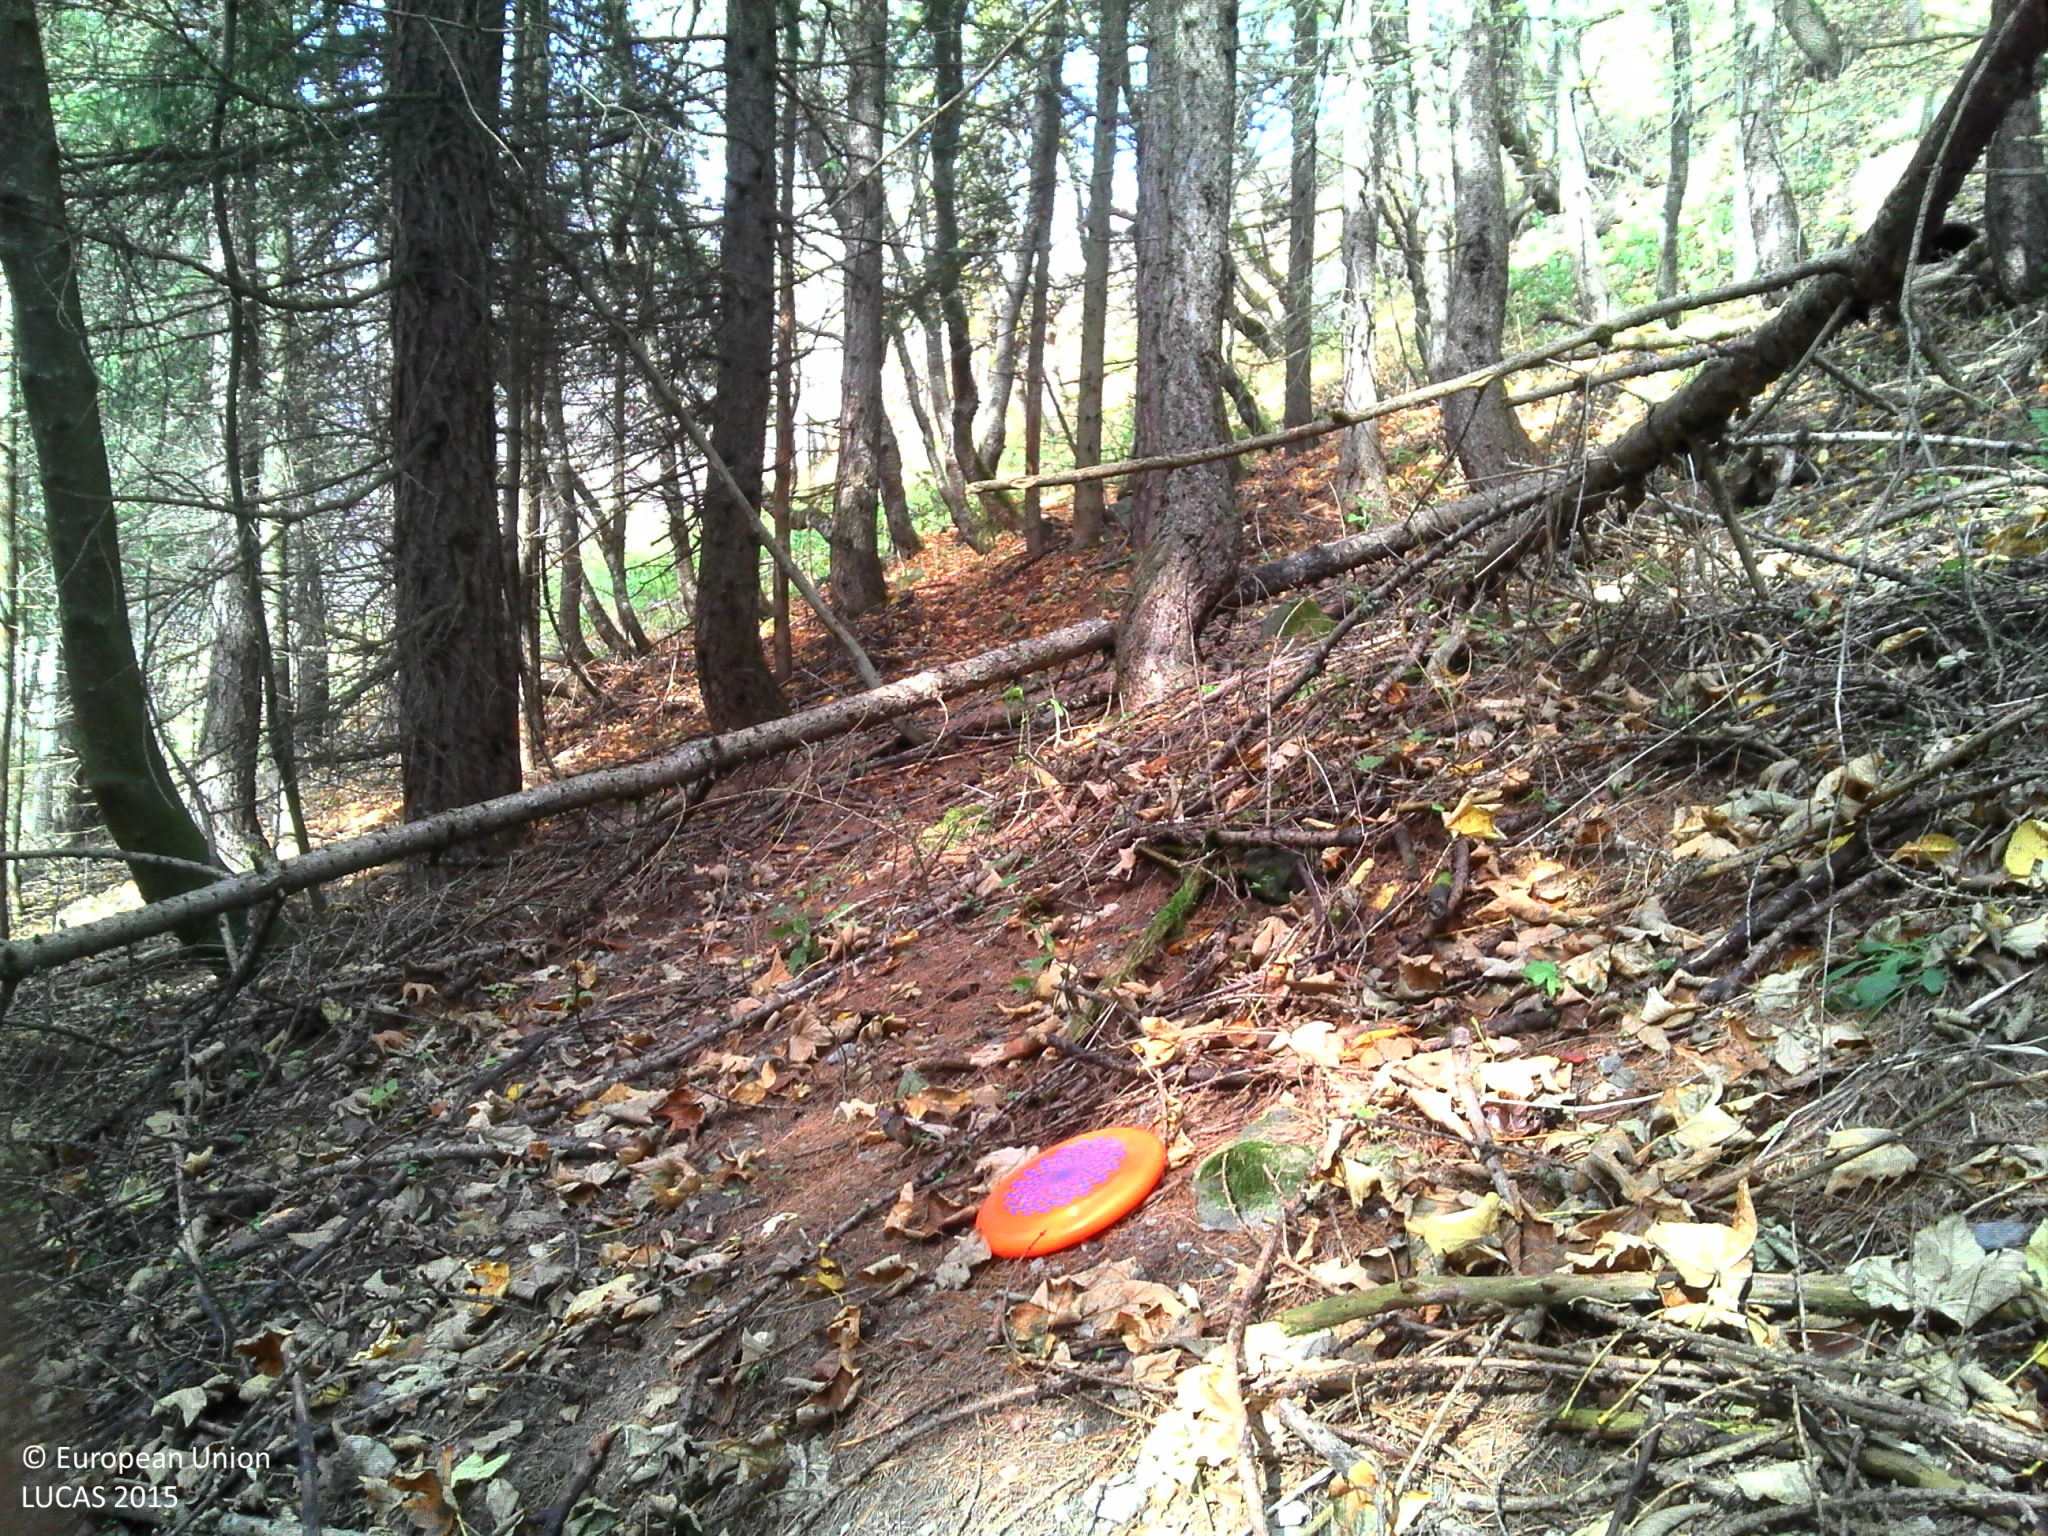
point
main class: Woodland
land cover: Other mixed woodland
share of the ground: > 75 %
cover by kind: coniferous forest trees 50 %, broadleaved forest trees 30 %, unconsolidated bare surface 15 %, shrubs 5 %
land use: Forestry
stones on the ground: < 10 %
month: October
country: FR
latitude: 45.1735
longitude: 6.4297
